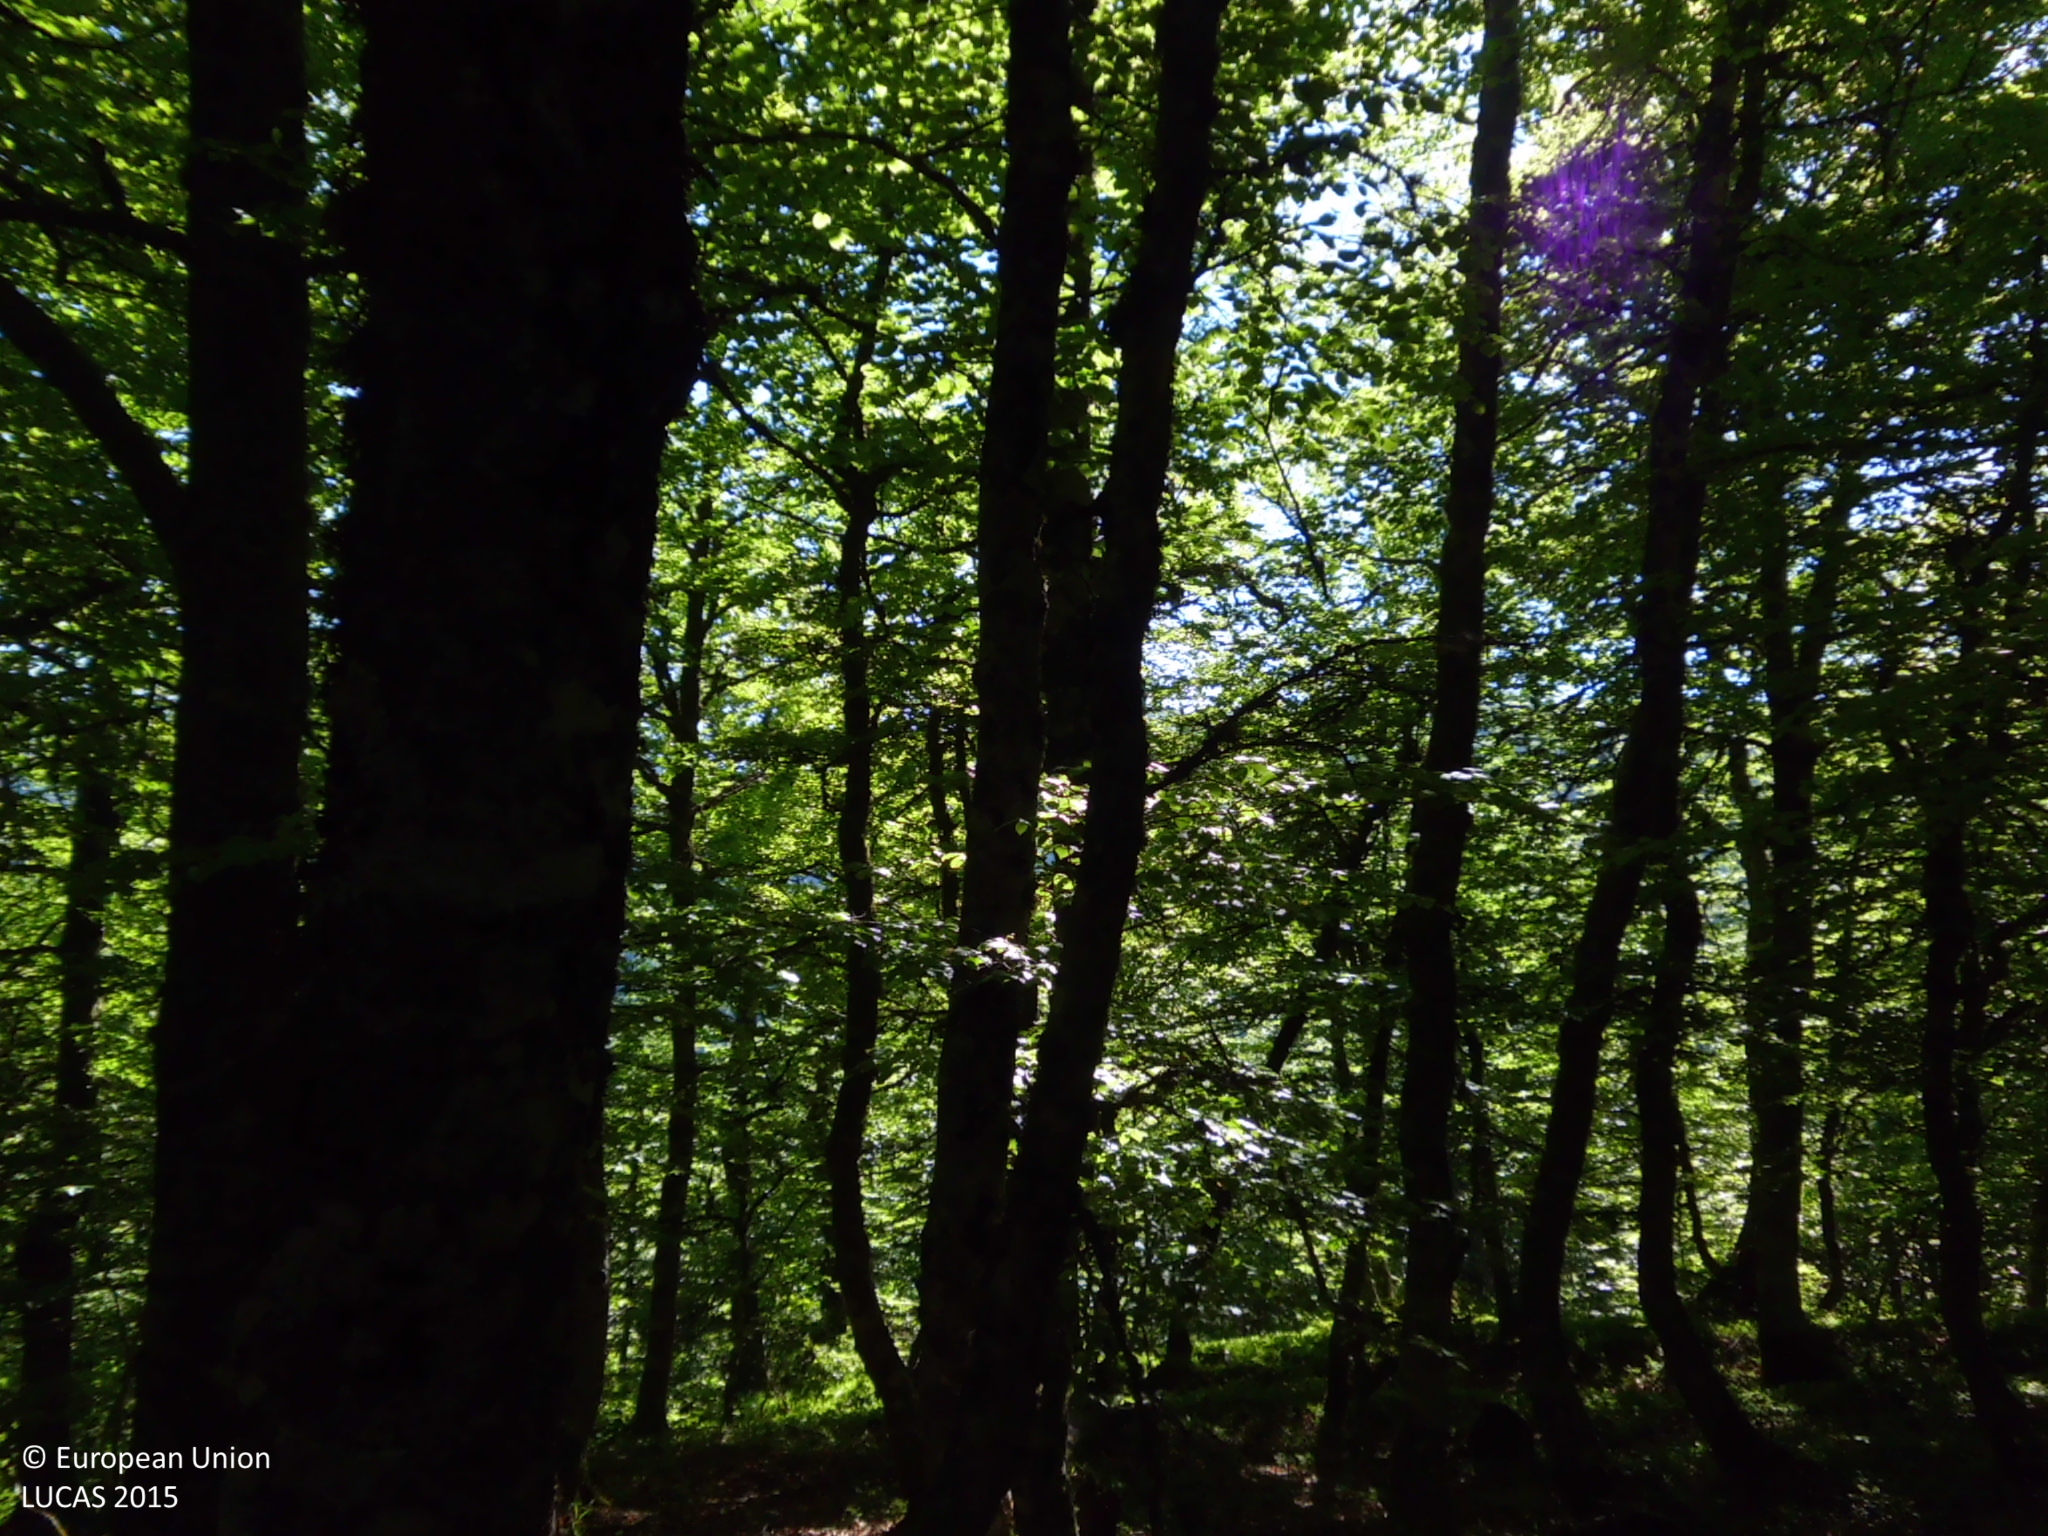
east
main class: Woodland
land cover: Broadleaved woodland
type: mountainous beech forest
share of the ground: 50 - 75 %
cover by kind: broadleaved forest trees 70 %, herbaceous plants 25 %, shrubs 5 %
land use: Semi-natural and natural areas not in use
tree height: > 5 m
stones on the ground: > 50 %
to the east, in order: Broadleaved woodland; Rock outcrops; Broadleaved woodland; Tracks; Broadleaved woodland
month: May
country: ES
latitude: 43.1032
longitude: -5.0210
